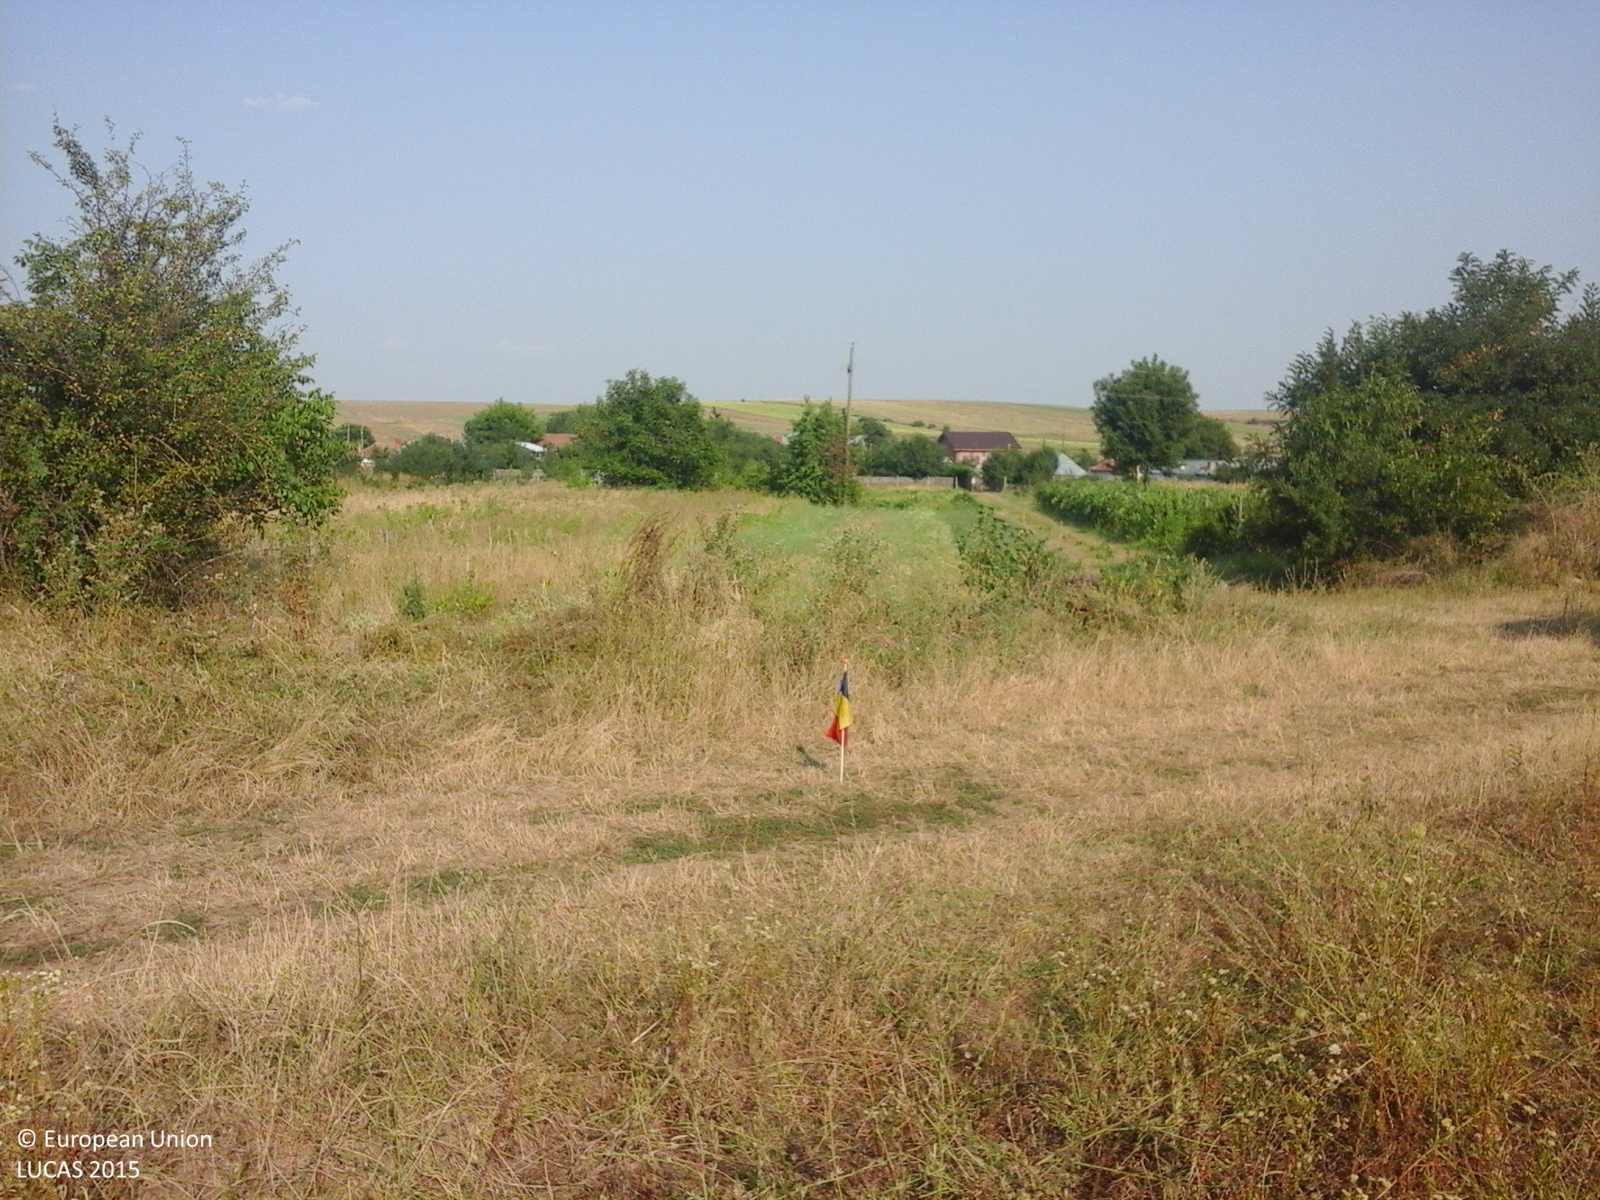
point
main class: Grassland
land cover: Grassland without tree/shrub cover
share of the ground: > 75 %
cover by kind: herbaceous plants 100 %
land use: Agriculture (excluding fallow land and kitchen gardens)
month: August
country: RO
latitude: 44.4236
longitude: 23.8373
